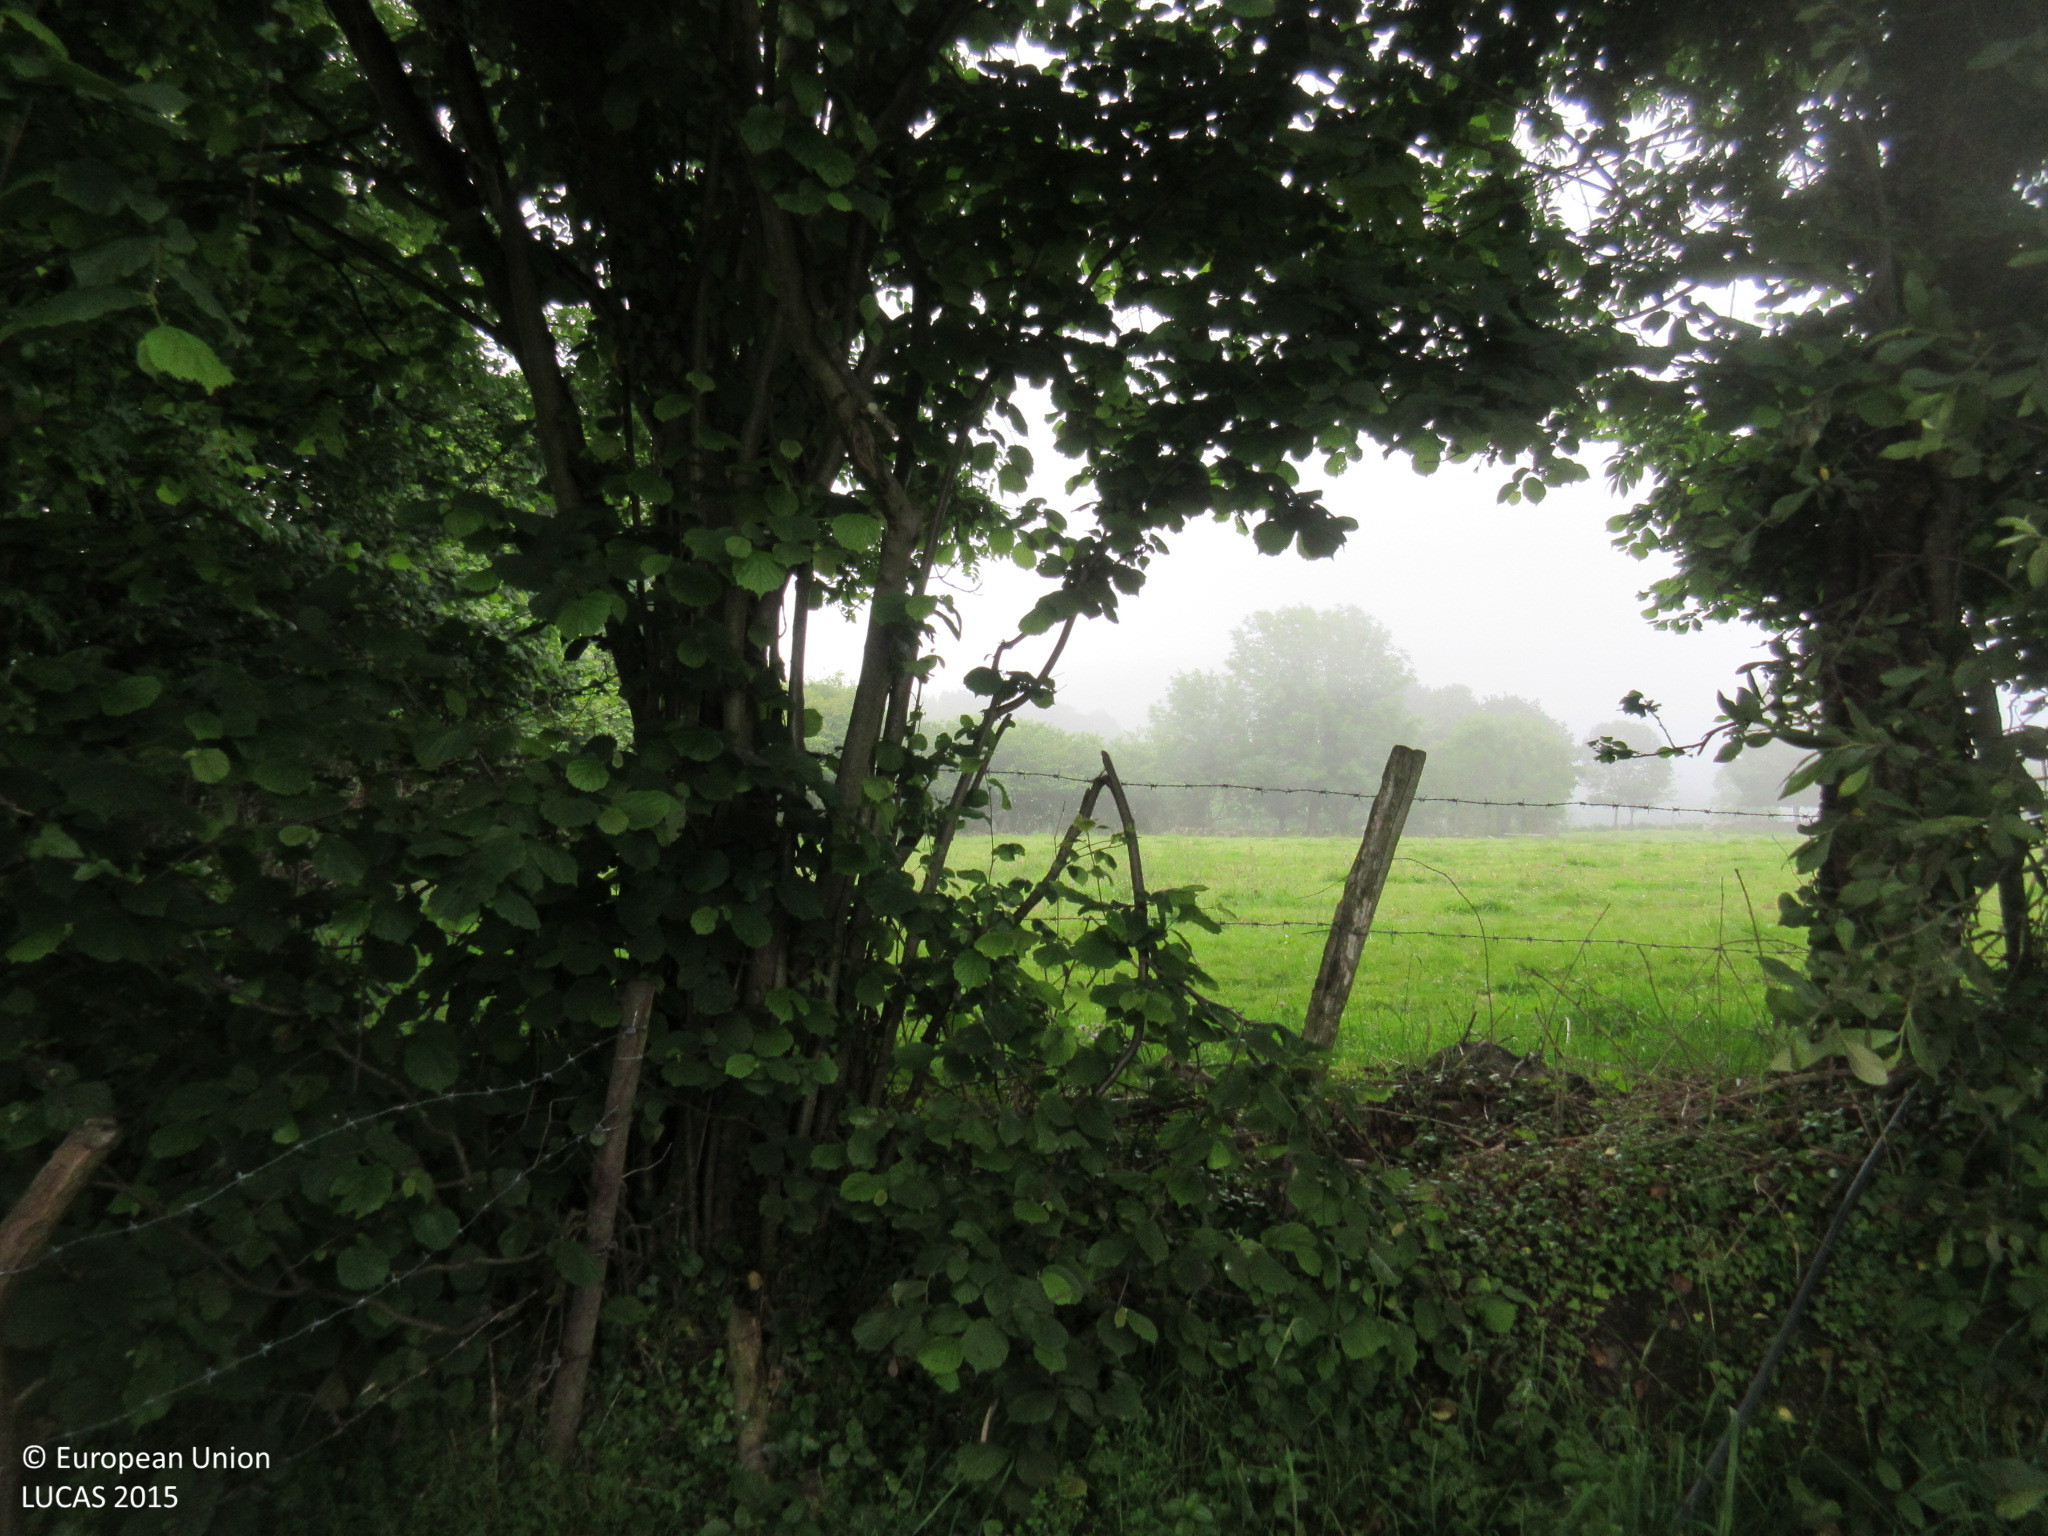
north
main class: Grassland
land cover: Grassland without tree/shrub cover
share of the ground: > 75 %
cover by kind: herbaceous plants 100 %
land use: Agriculture (excluding fallow land and kitchen gardens)
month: June
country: ES
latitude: 43.2893
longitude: -6.3044
